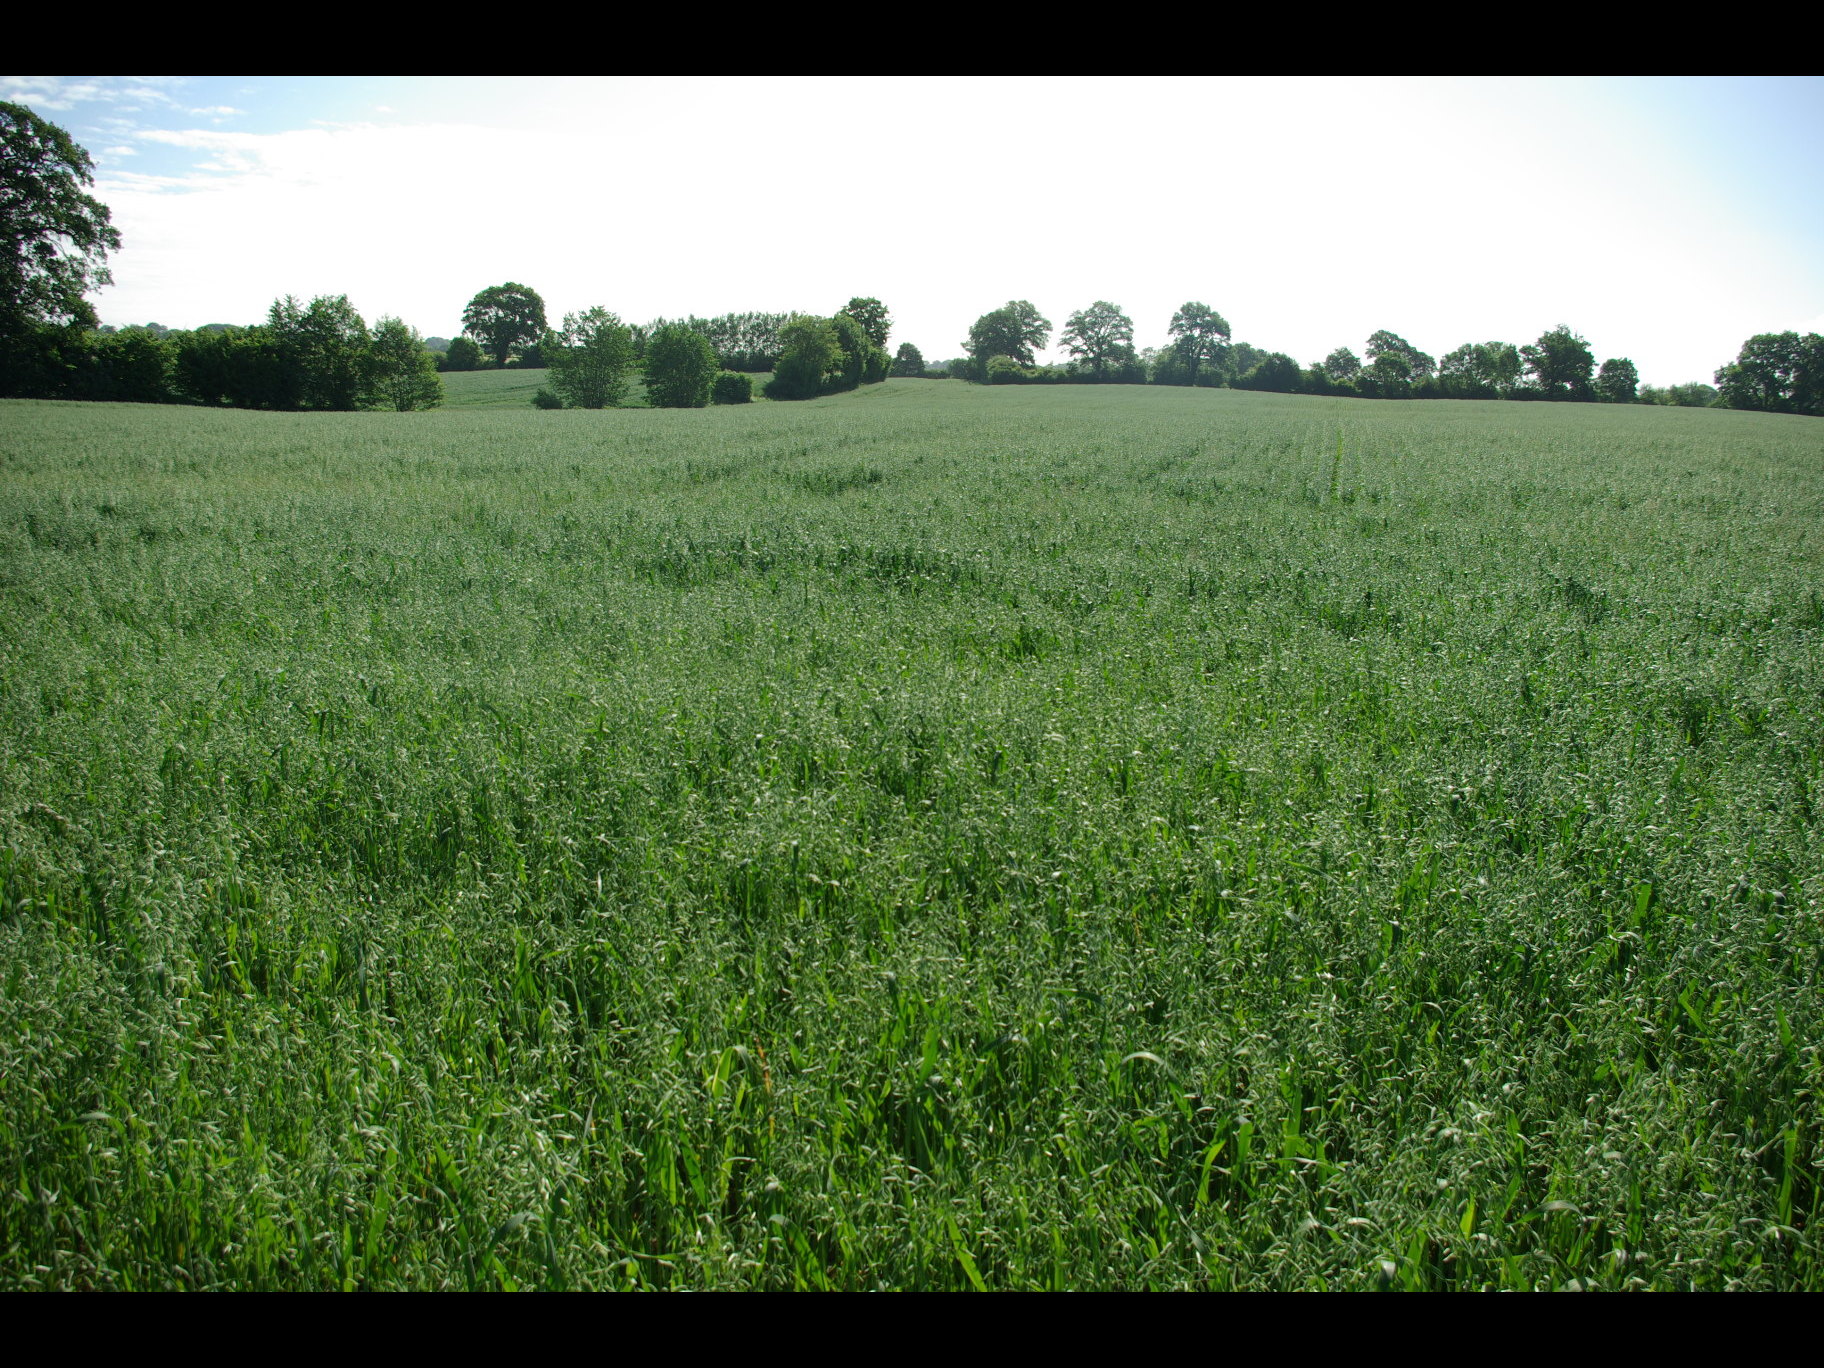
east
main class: Woodland
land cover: Broadleaved woodland
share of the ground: > 75 %
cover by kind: broadleaved forest trees 40 %, shrubs 40 %, herbaceous plants 20 %
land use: Agriculture (excluding fallow land and kitchen gardens)
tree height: > 5 m
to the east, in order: Broadleaved woodland; Oats
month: June
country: DE
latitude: 54.3724
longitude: 9.9538
